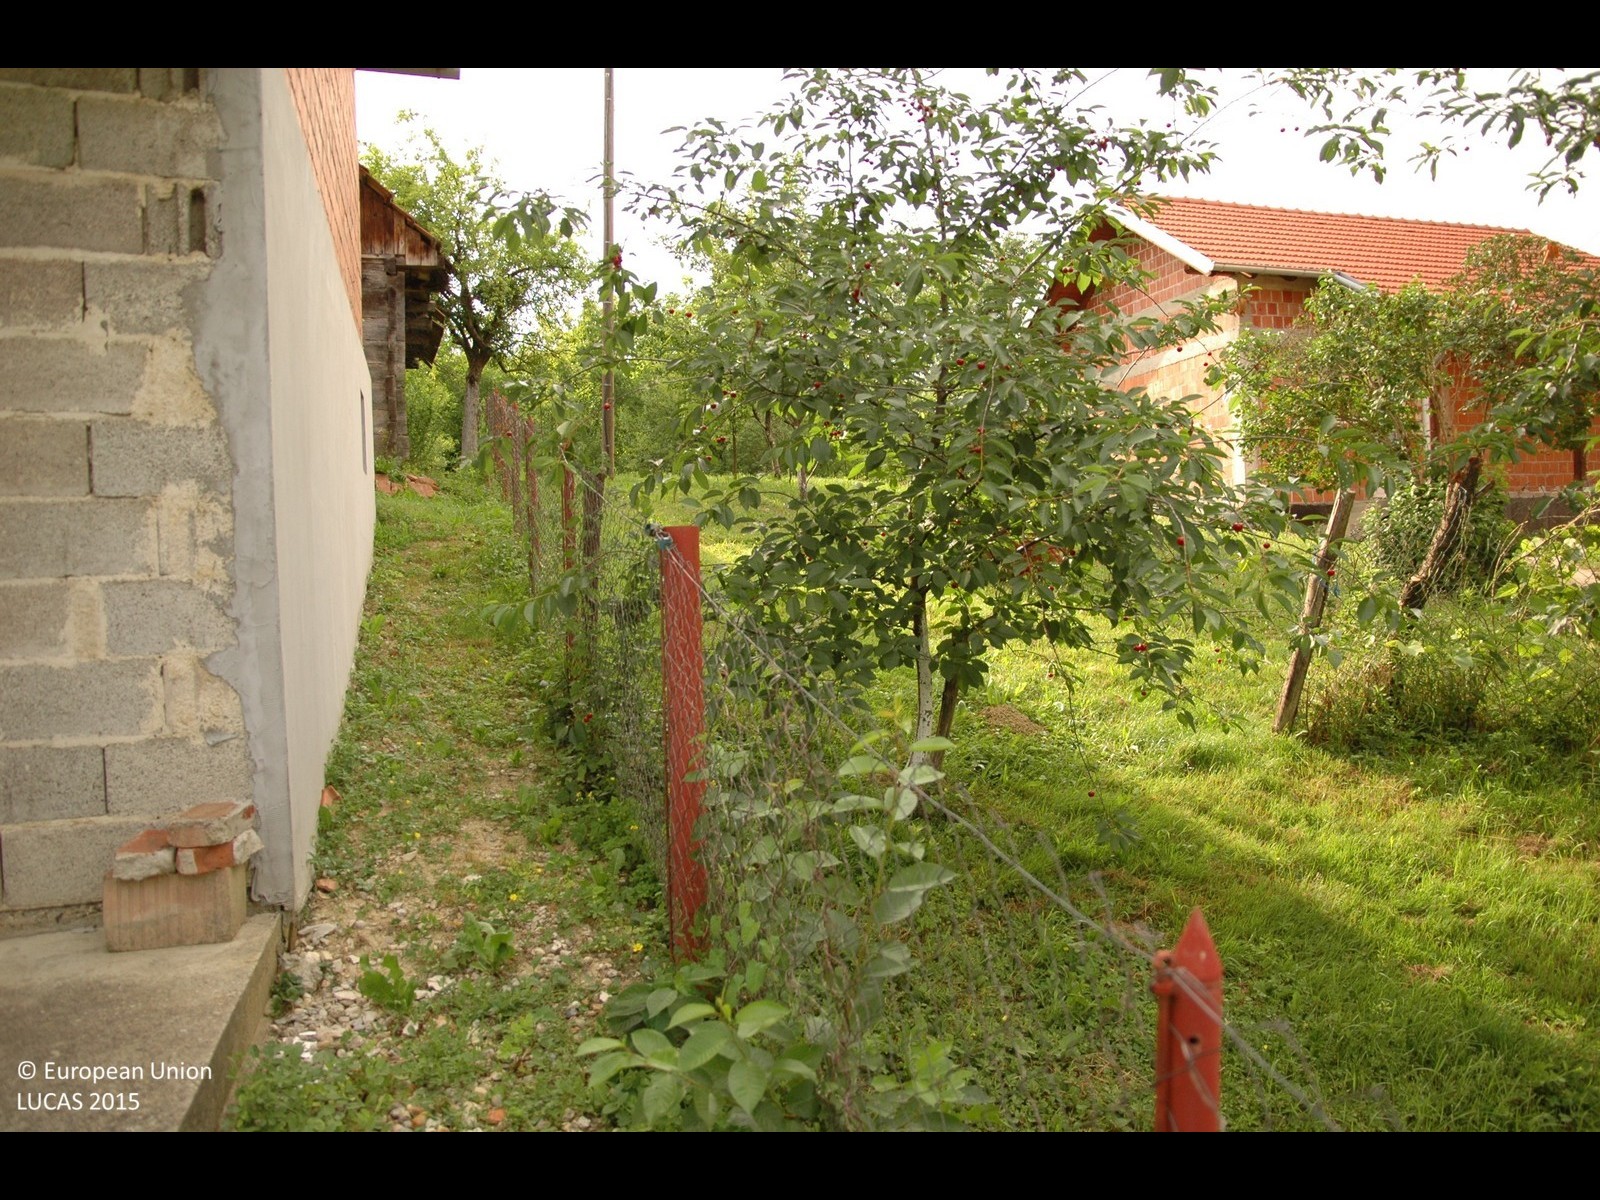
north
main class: Grassland
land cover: Grassland without tree/shrub cover
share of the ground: > 75 %
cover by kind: herbaceous plants 100 %
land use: Residential
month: June
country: HR
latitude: 46.1651
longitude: 16.3068
